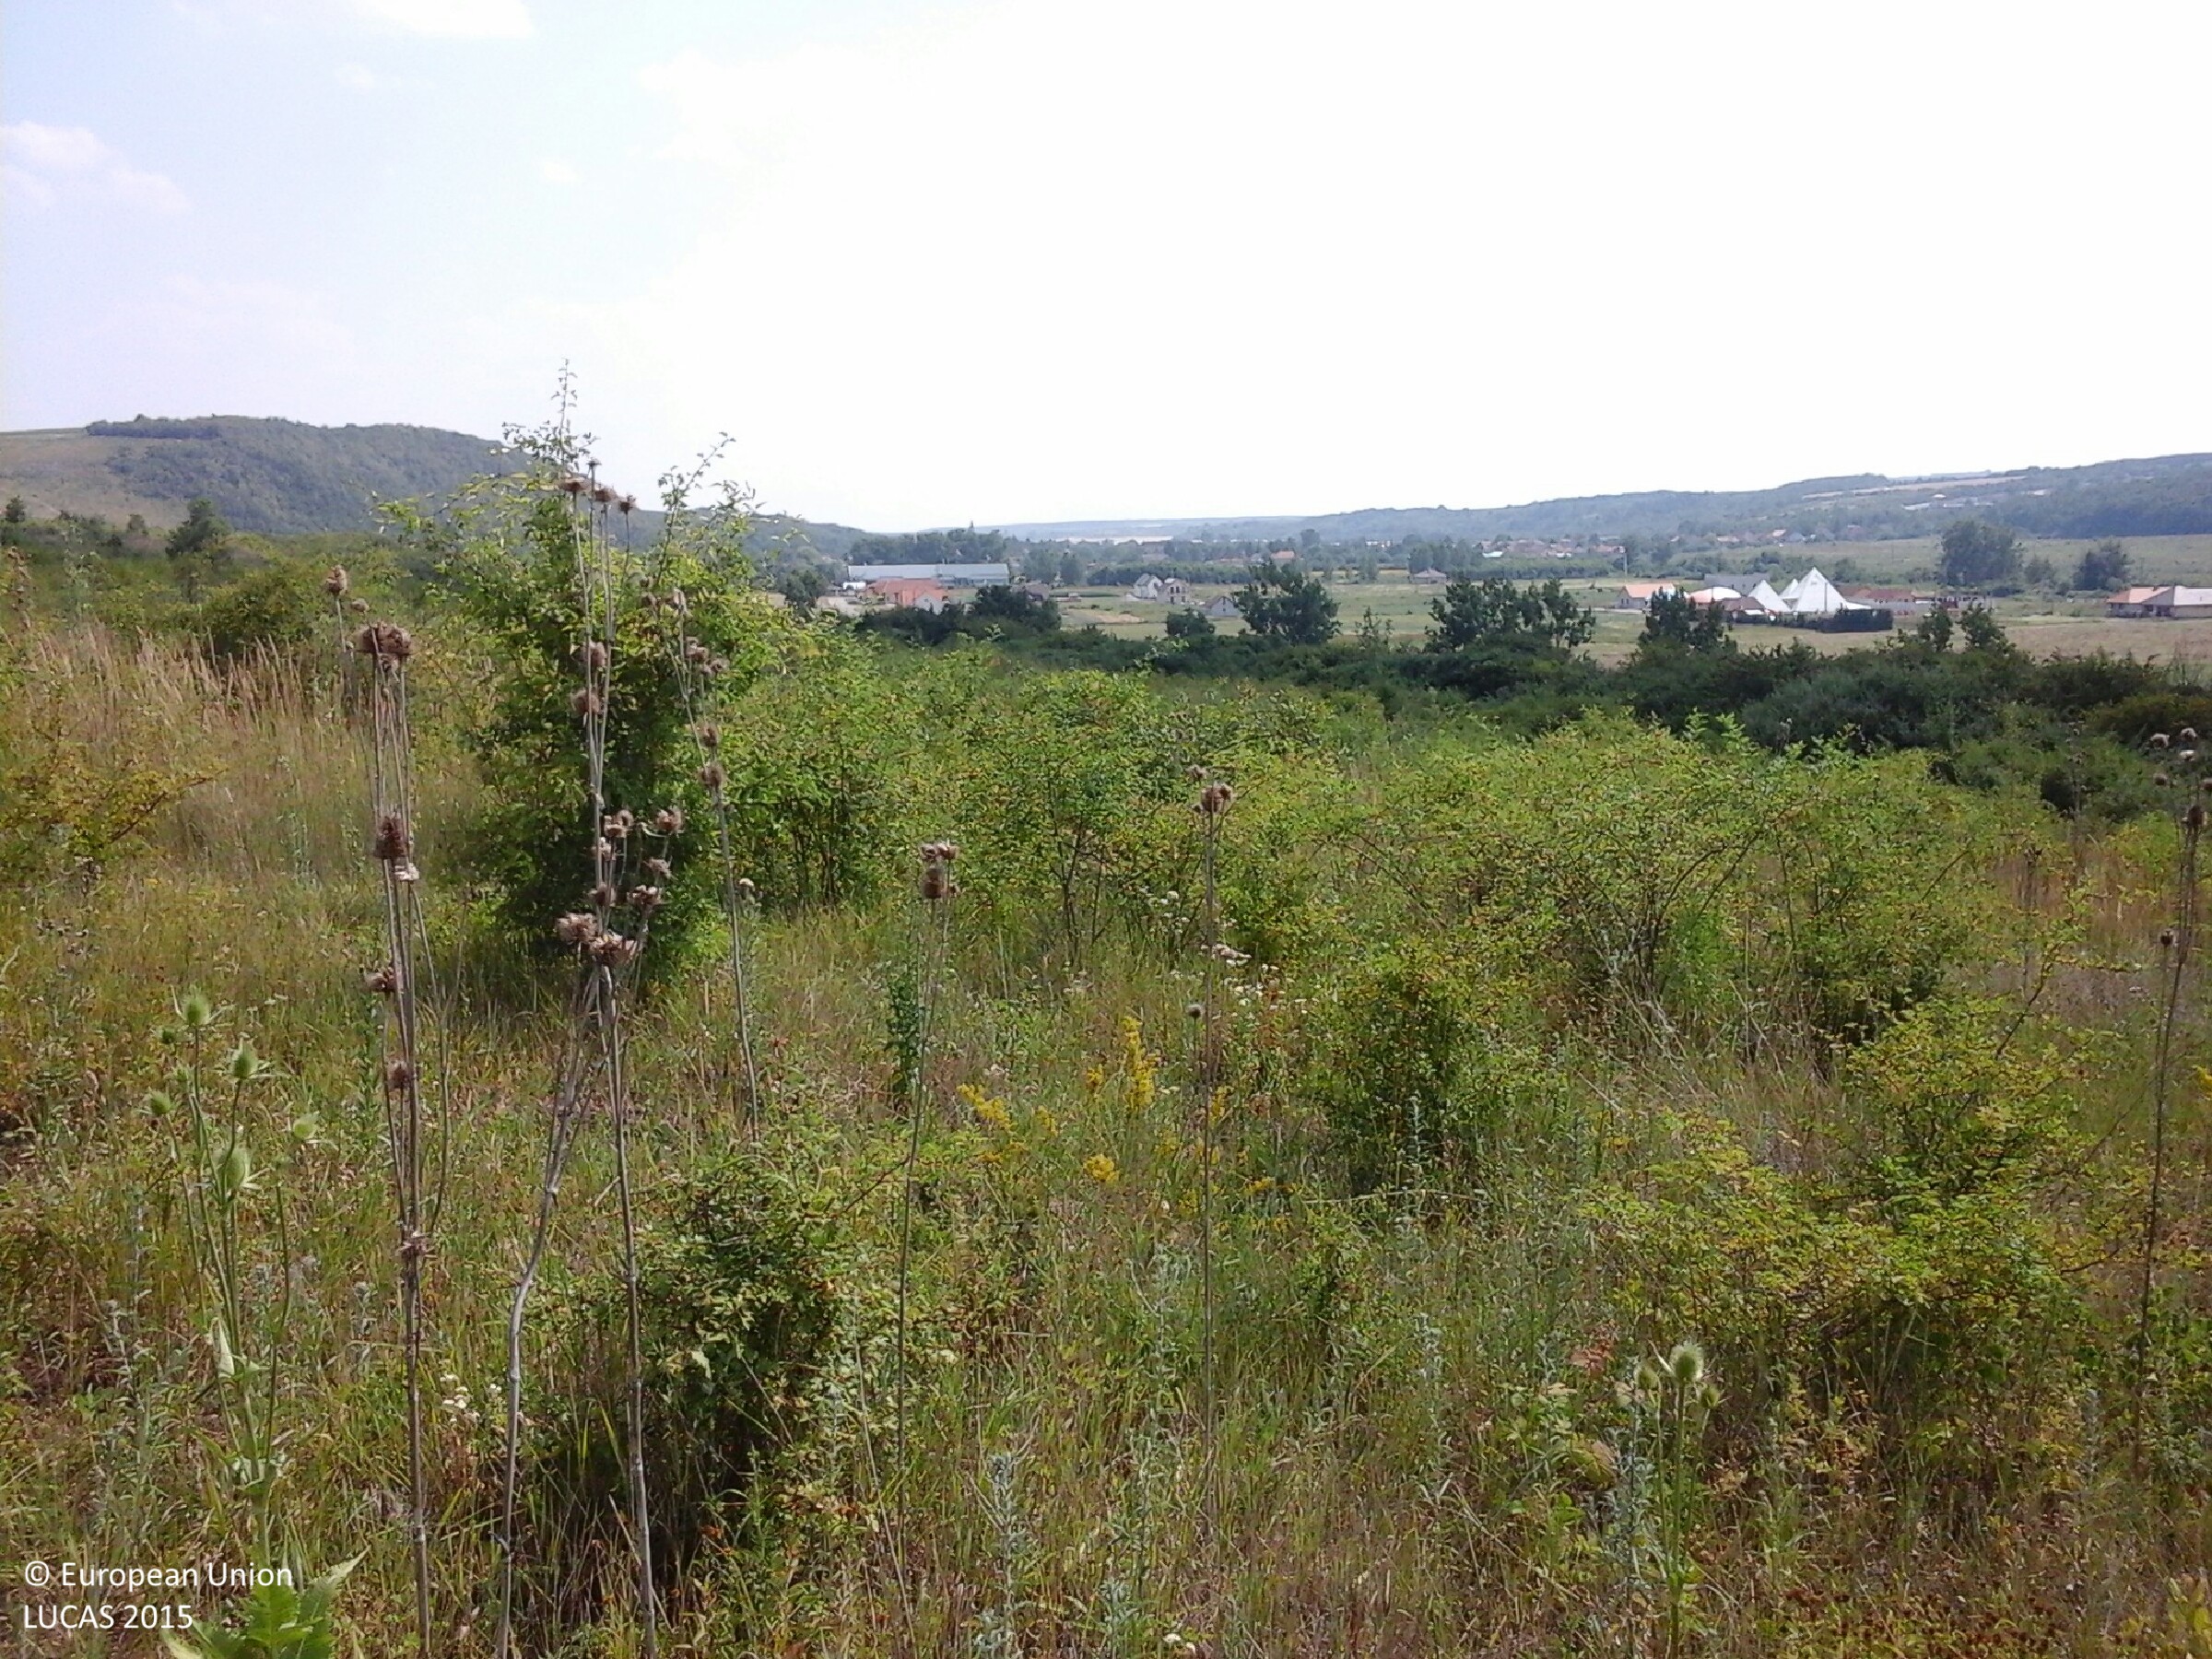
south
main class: Shrubland
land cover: Shrubland without tree cover
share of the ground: 50 - 75 %
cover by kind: shrubs 50 %, herbaceous plants 50 %
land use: Abandoned areas
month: July
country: HU
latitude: 47.8455
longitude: 20.3335
